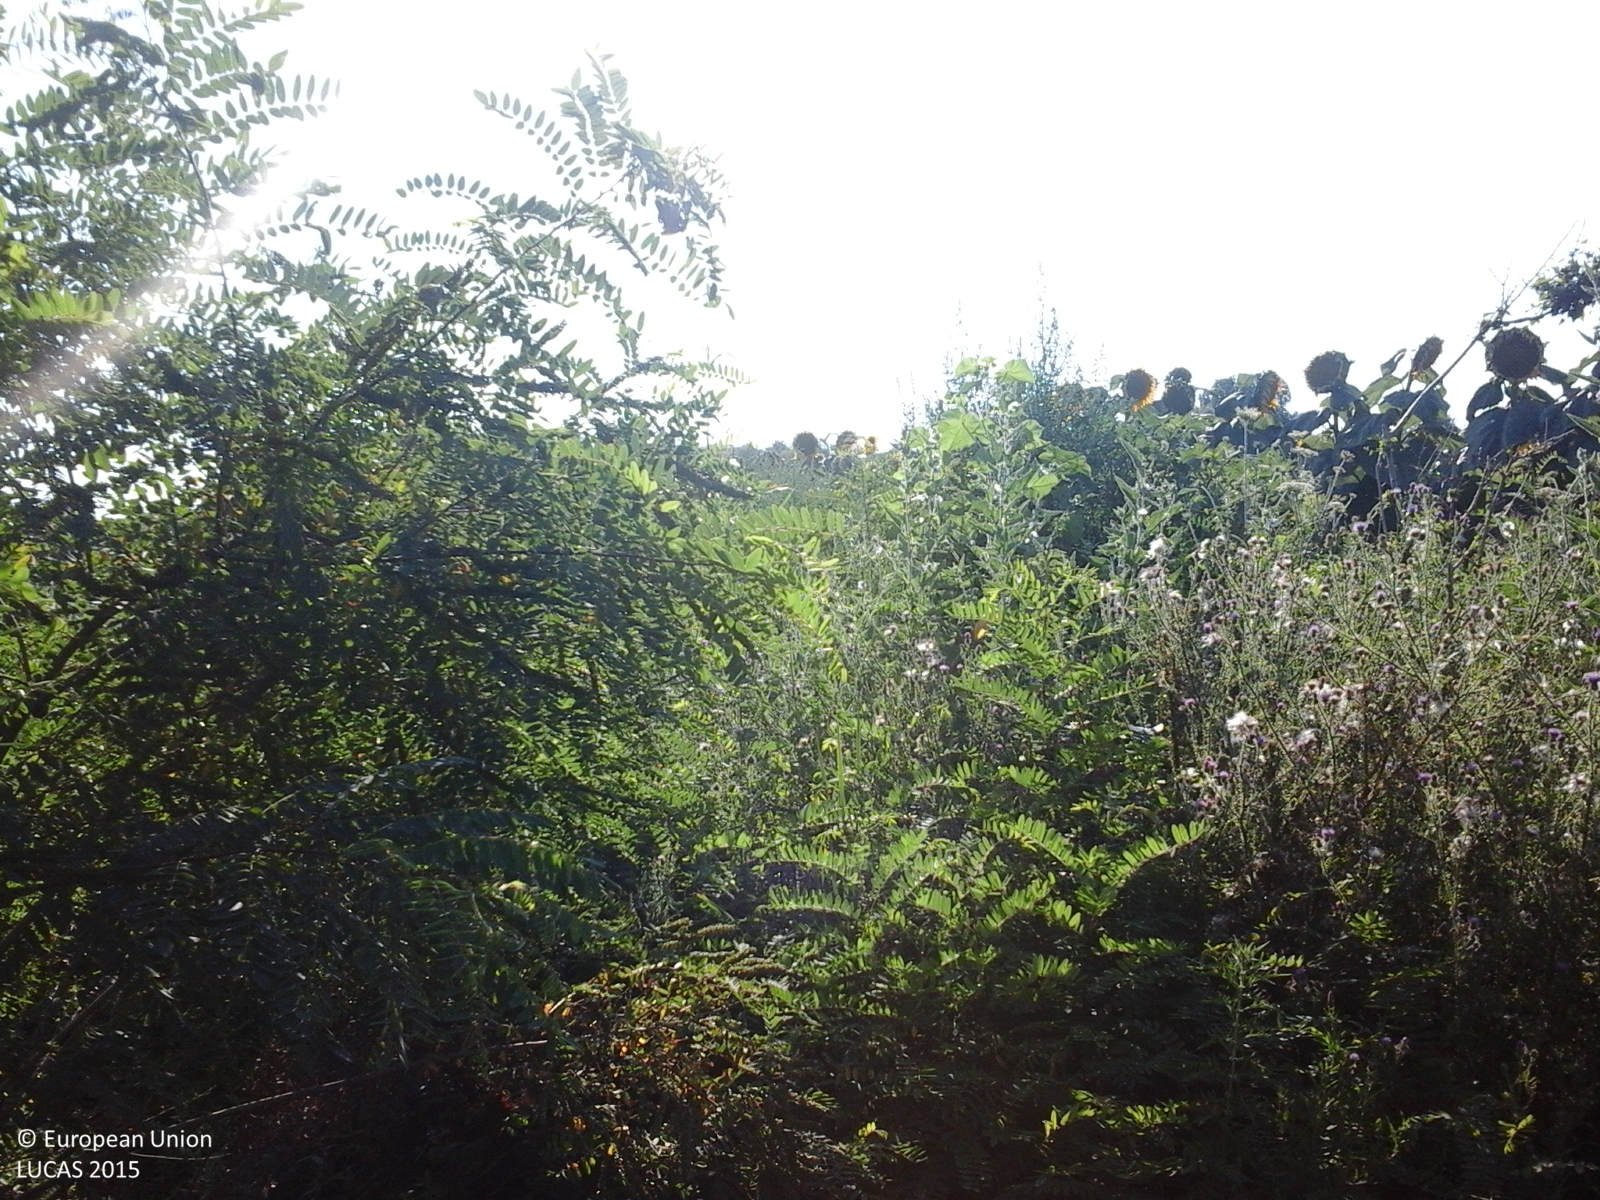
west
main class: Grassland
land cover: Spontaneously vegetated surfaces
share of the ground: > 75 %
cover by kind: herbaceous plants 100 %
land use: Semi-natural and natural areas not in use
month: July
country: RO
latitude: 44.3186
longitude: 27.7389
